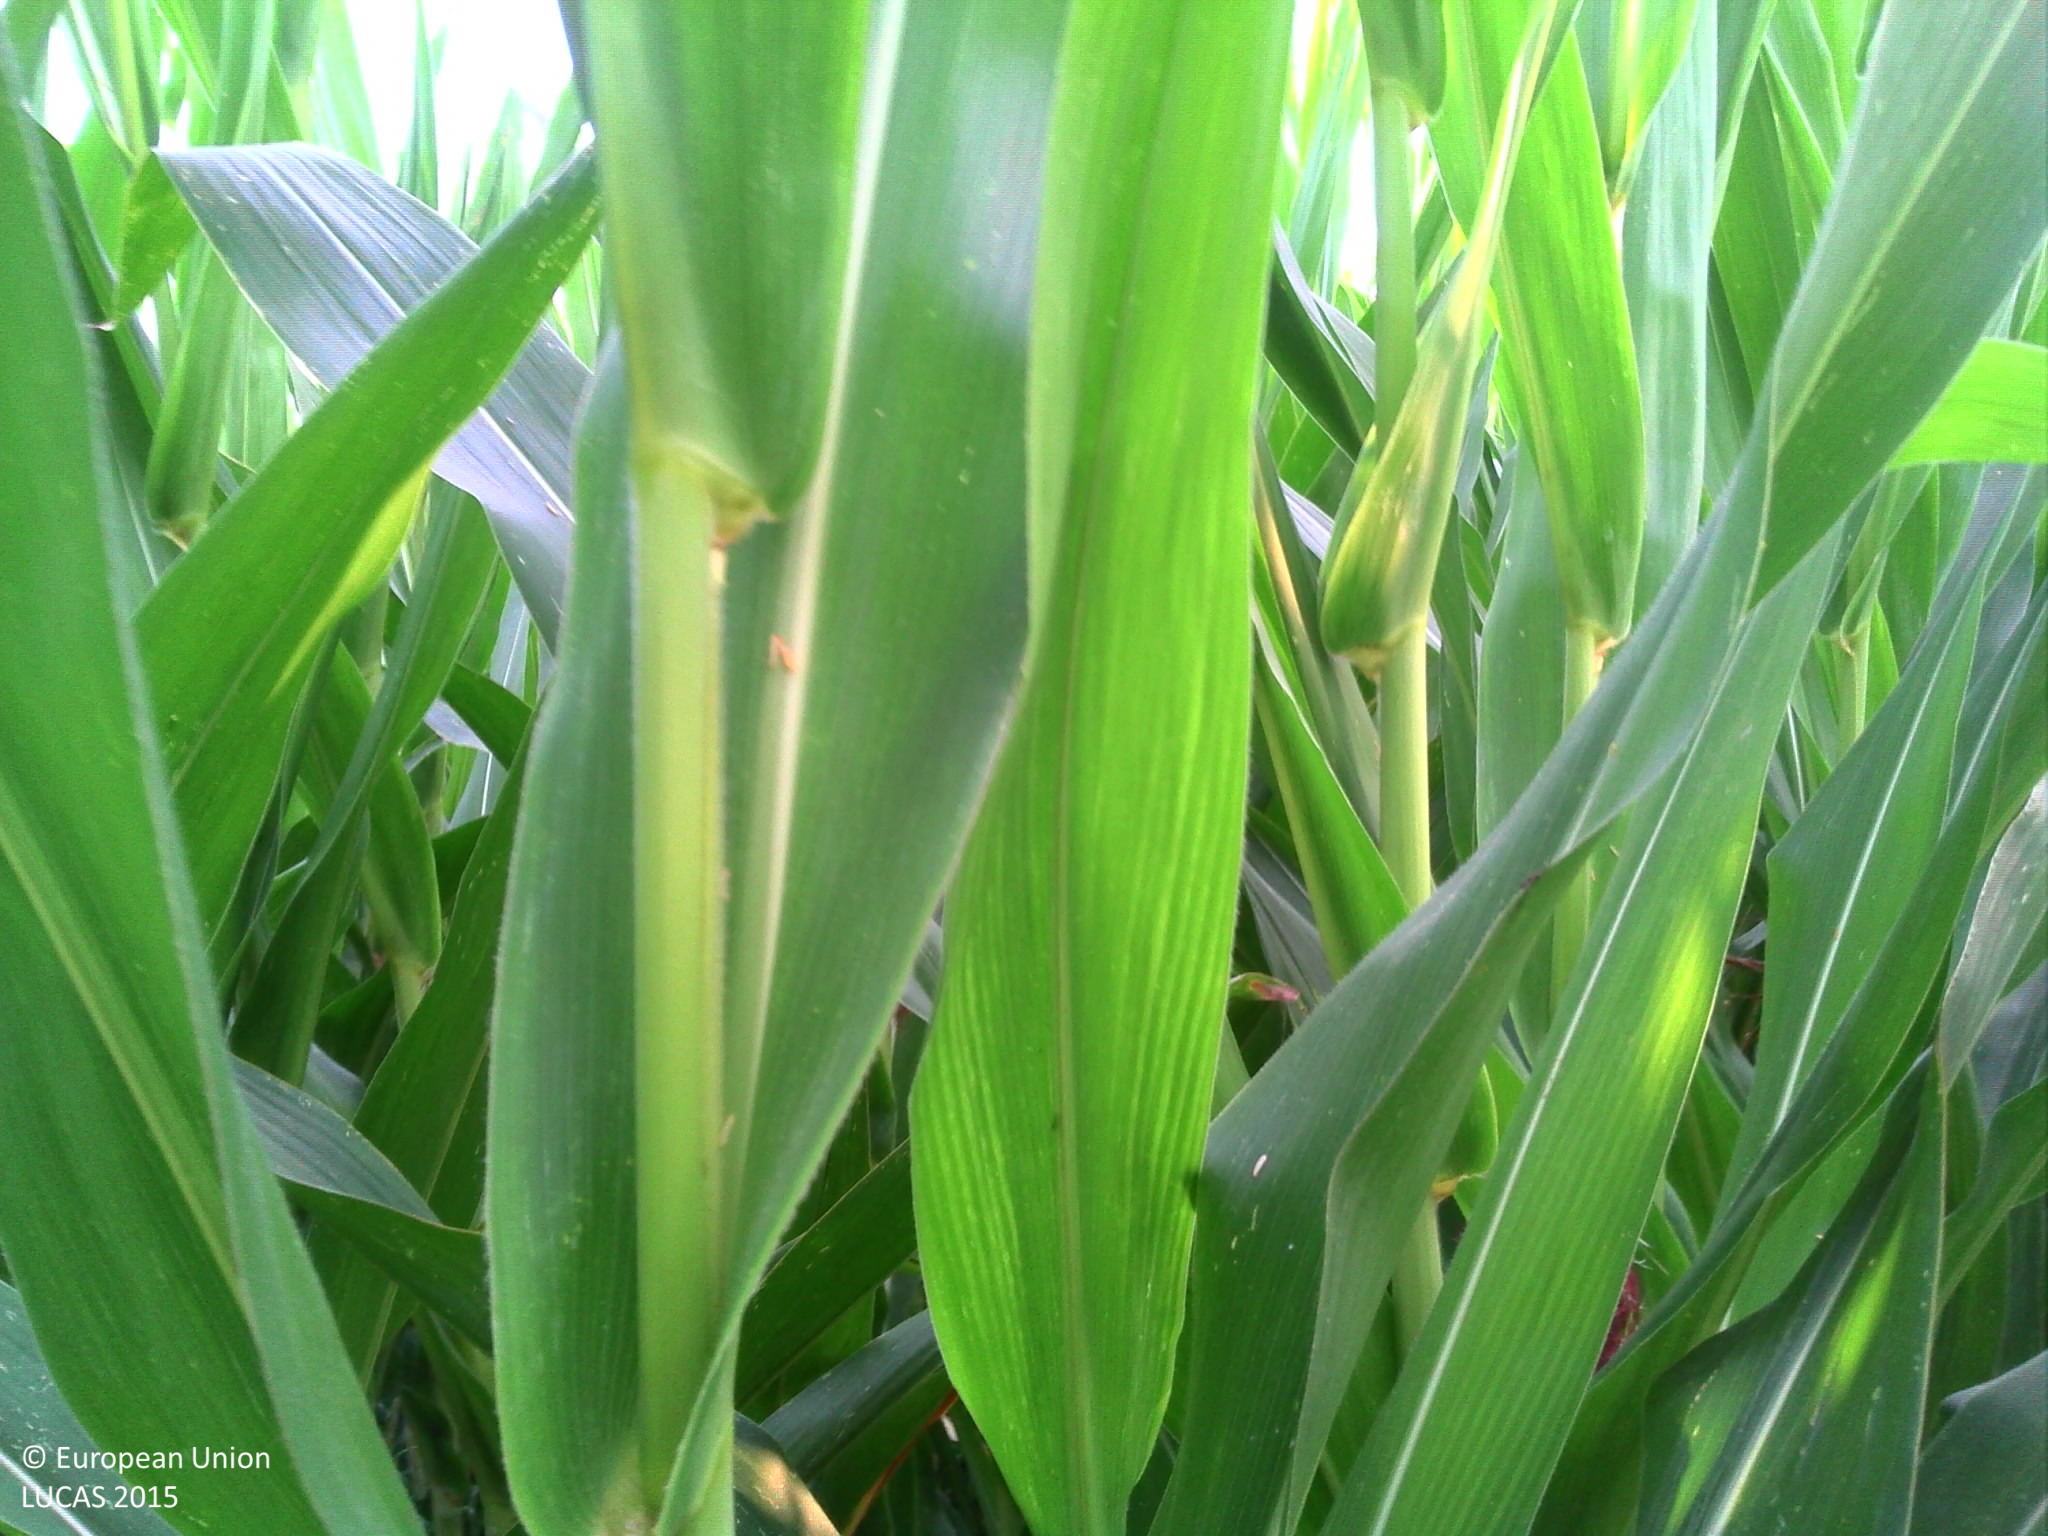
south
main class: Cropland
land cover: Maize
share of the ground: > 75 %
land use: Agriculture (excluding fallow land and kitchen gardens)
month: August
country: FR
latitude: 43.3933
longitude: -1.0629
